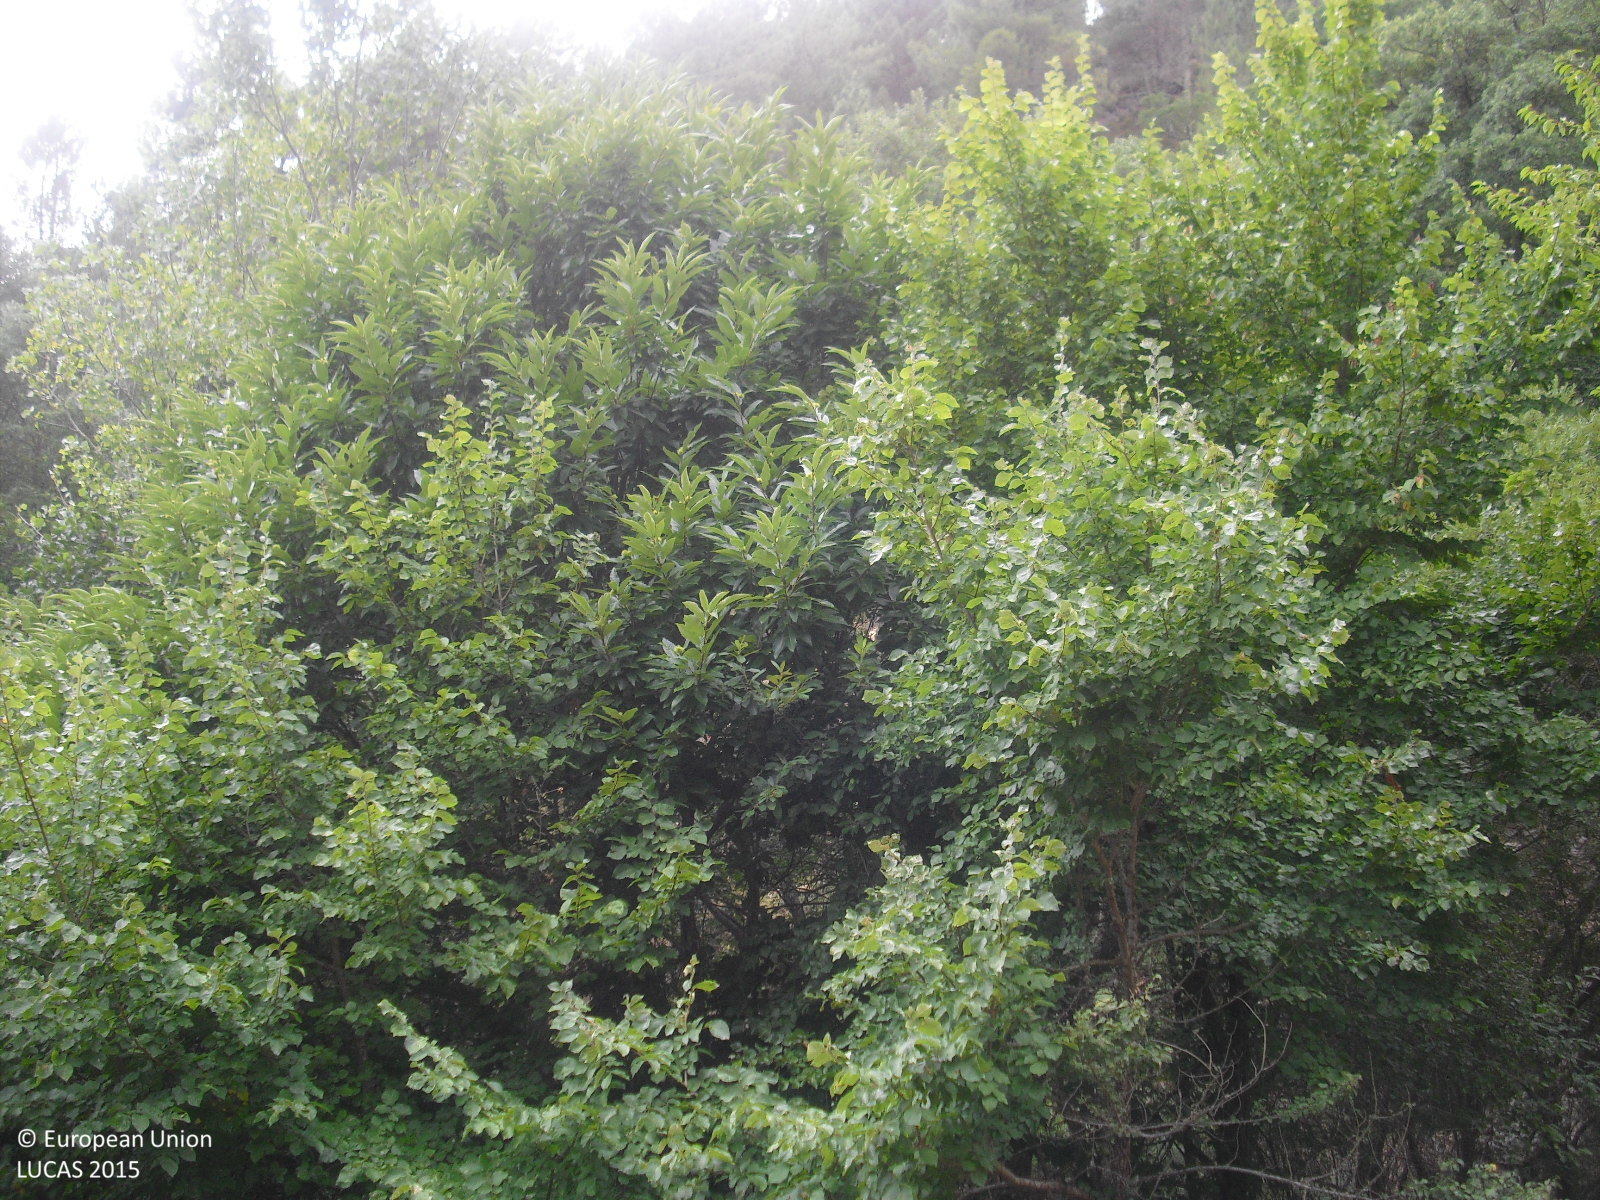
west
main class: Woodland
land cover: Broadleaved woodland
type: thermophilous deciduous forest
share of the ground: > 75 %
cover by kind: broadleaved forest trees 70 %, shrubs 30 %
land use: Semi-natural and natural areas not in use
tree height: > 5 m
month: July
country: ES
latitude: 42.4559
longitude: -7.2188
